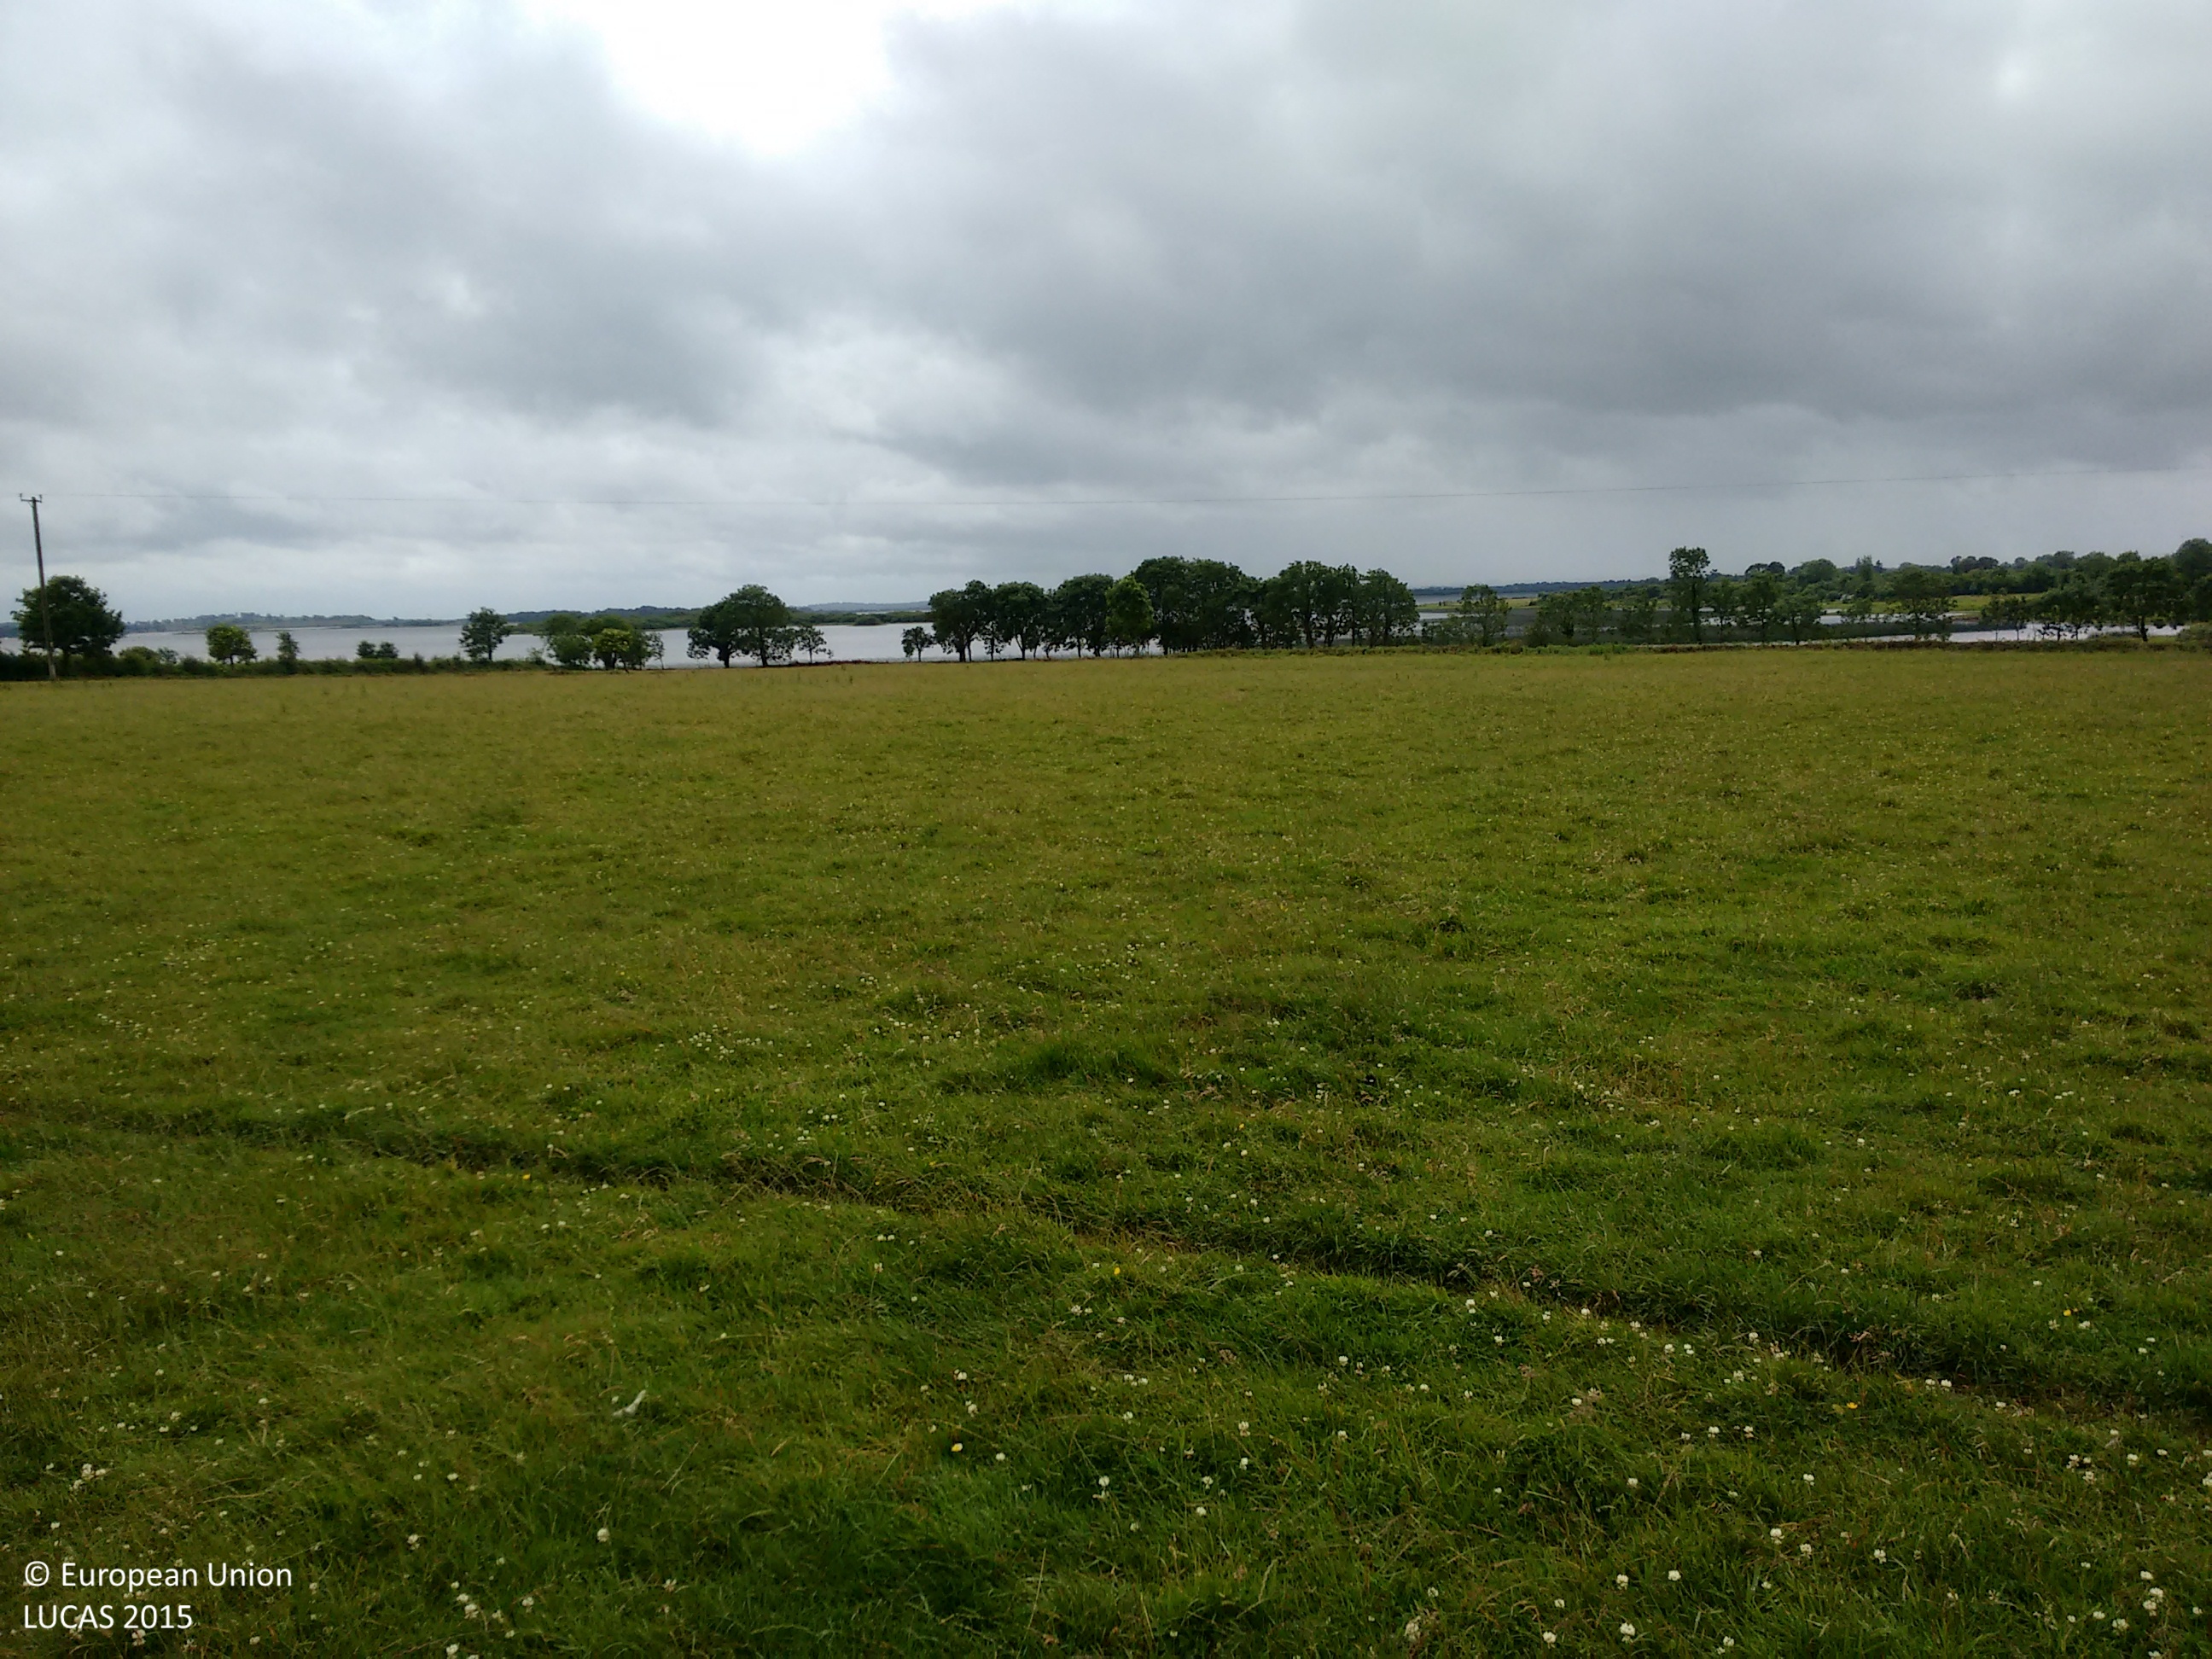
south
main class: Grassland
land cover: Grassland without tree/shrub cover
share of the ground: > 75 %
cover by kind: herbaceous plants 100 %
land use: Agriculture (excluding fallow land and kitchen gardens)
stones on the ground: < 10 %
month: July
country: IE
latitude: 53.6536
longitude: -8.0453
